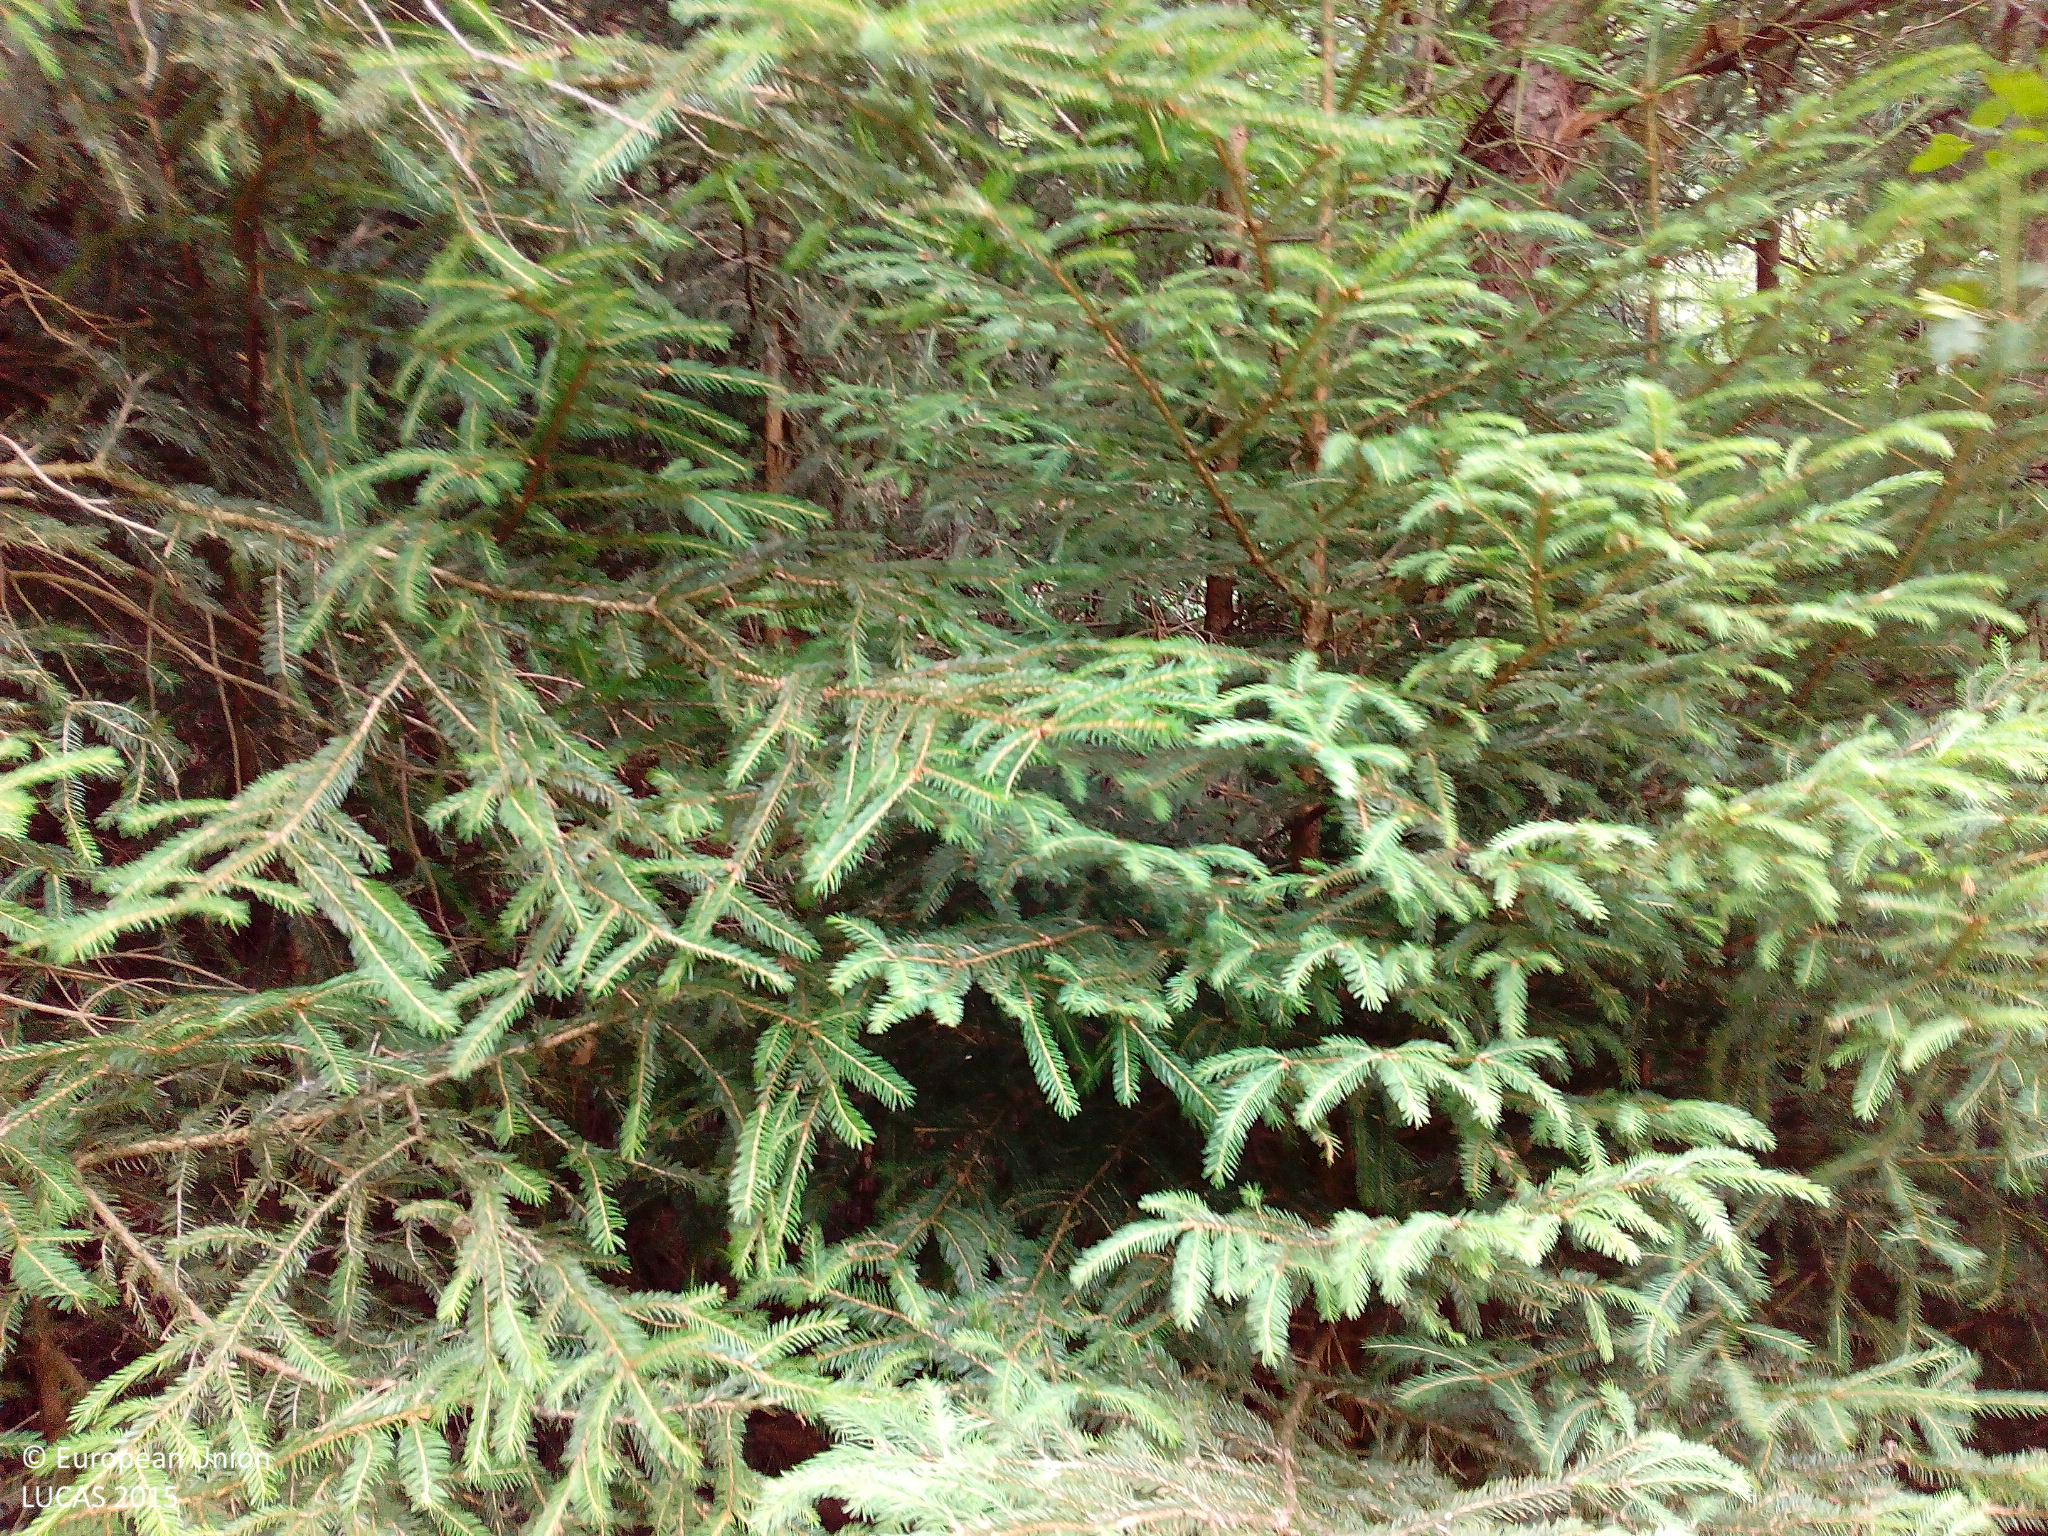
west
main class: Woodland
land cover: Spruce dominated mixed woodland
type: hemiboreal forest and nemoral coniferous forest and mixed broadleaved-coniferous forest
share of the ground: > 75 %
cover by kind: coniferous forest trees 60 %, broadleaved forest trees 40 %
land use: Forestry
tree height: > 5 m
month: July
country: DE
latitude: 50.8135
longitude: 9.9574
